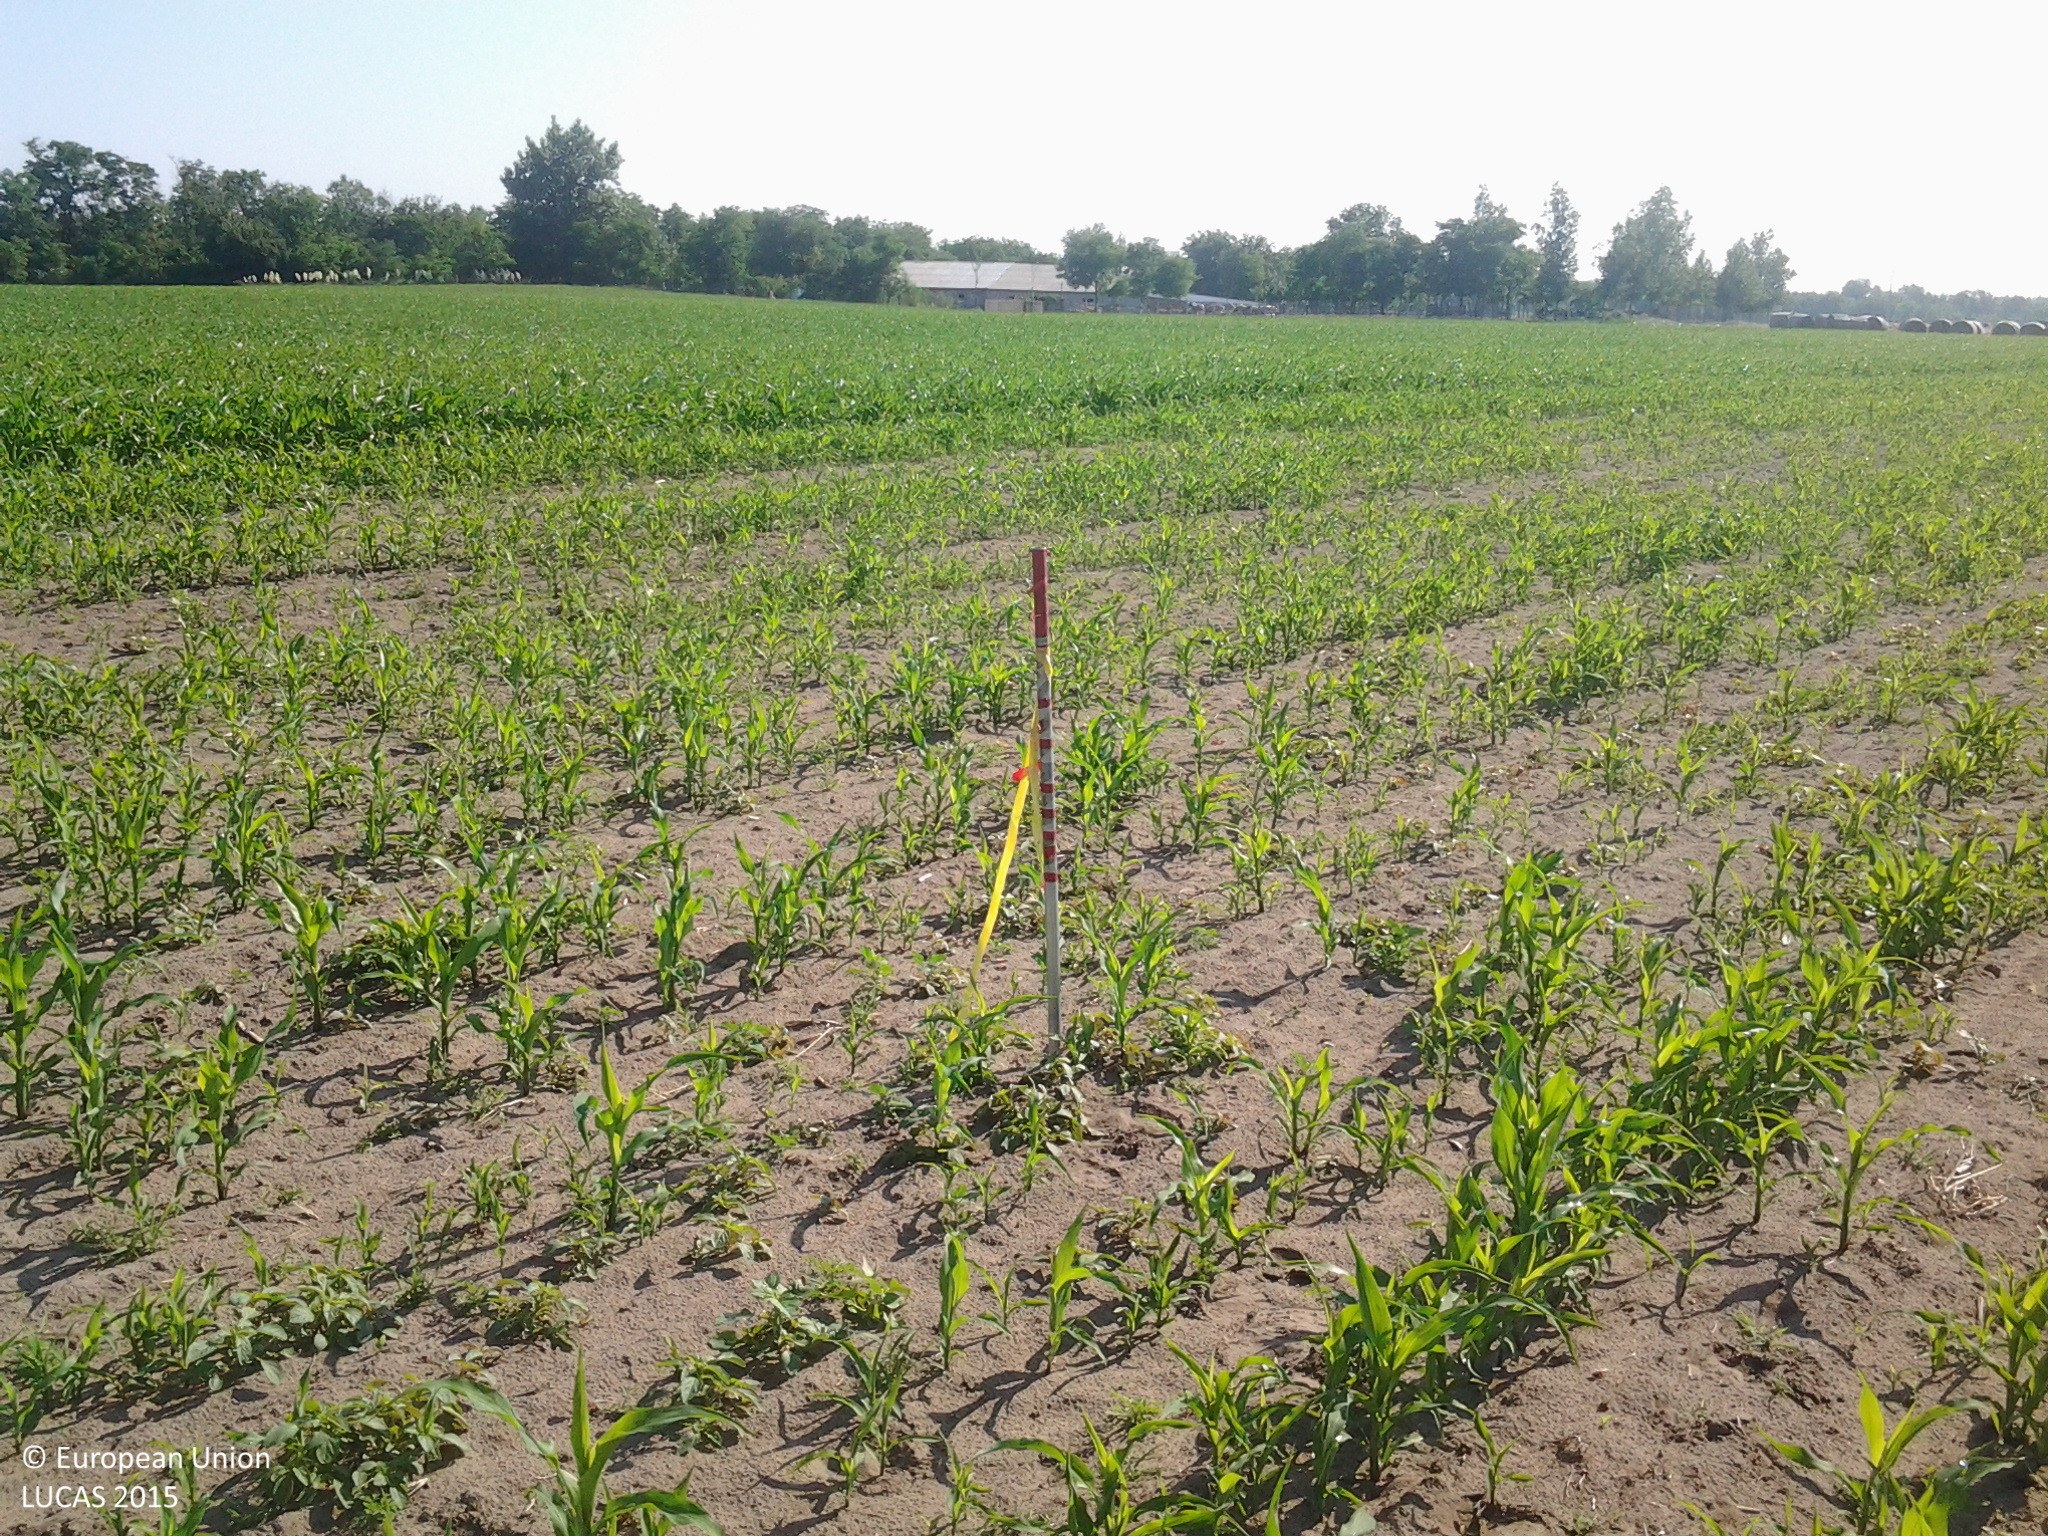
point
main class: Cropland
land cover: Maize
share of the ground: 50 - 75 %
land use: Agriculture (excluding fallow land and kitchen gardens)
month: July
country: HU
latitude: 46.6310
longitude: 19.5402
